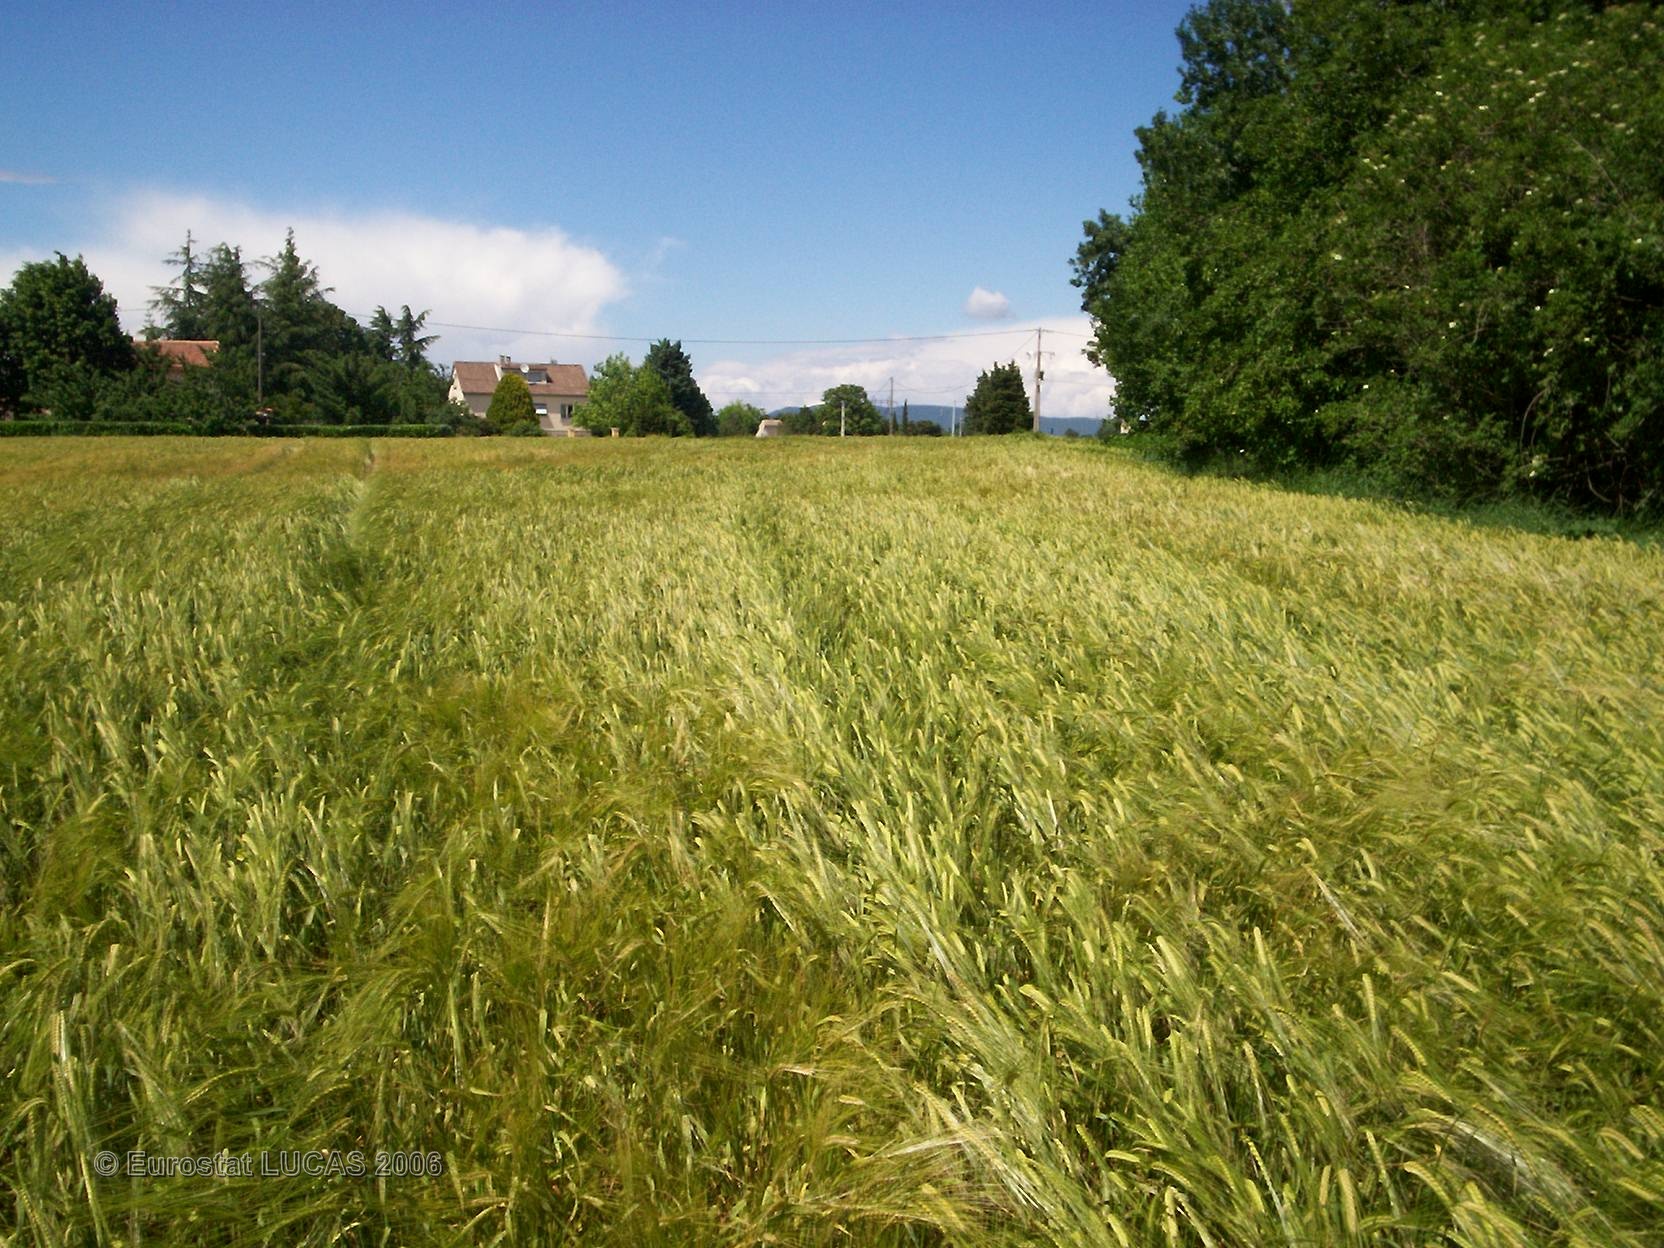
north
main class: Cropland
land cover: Barley
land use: Agriculture (excluding fallow land and kitchen gardens)
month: May
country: FR
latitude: 44.5471
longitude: 4.8335
